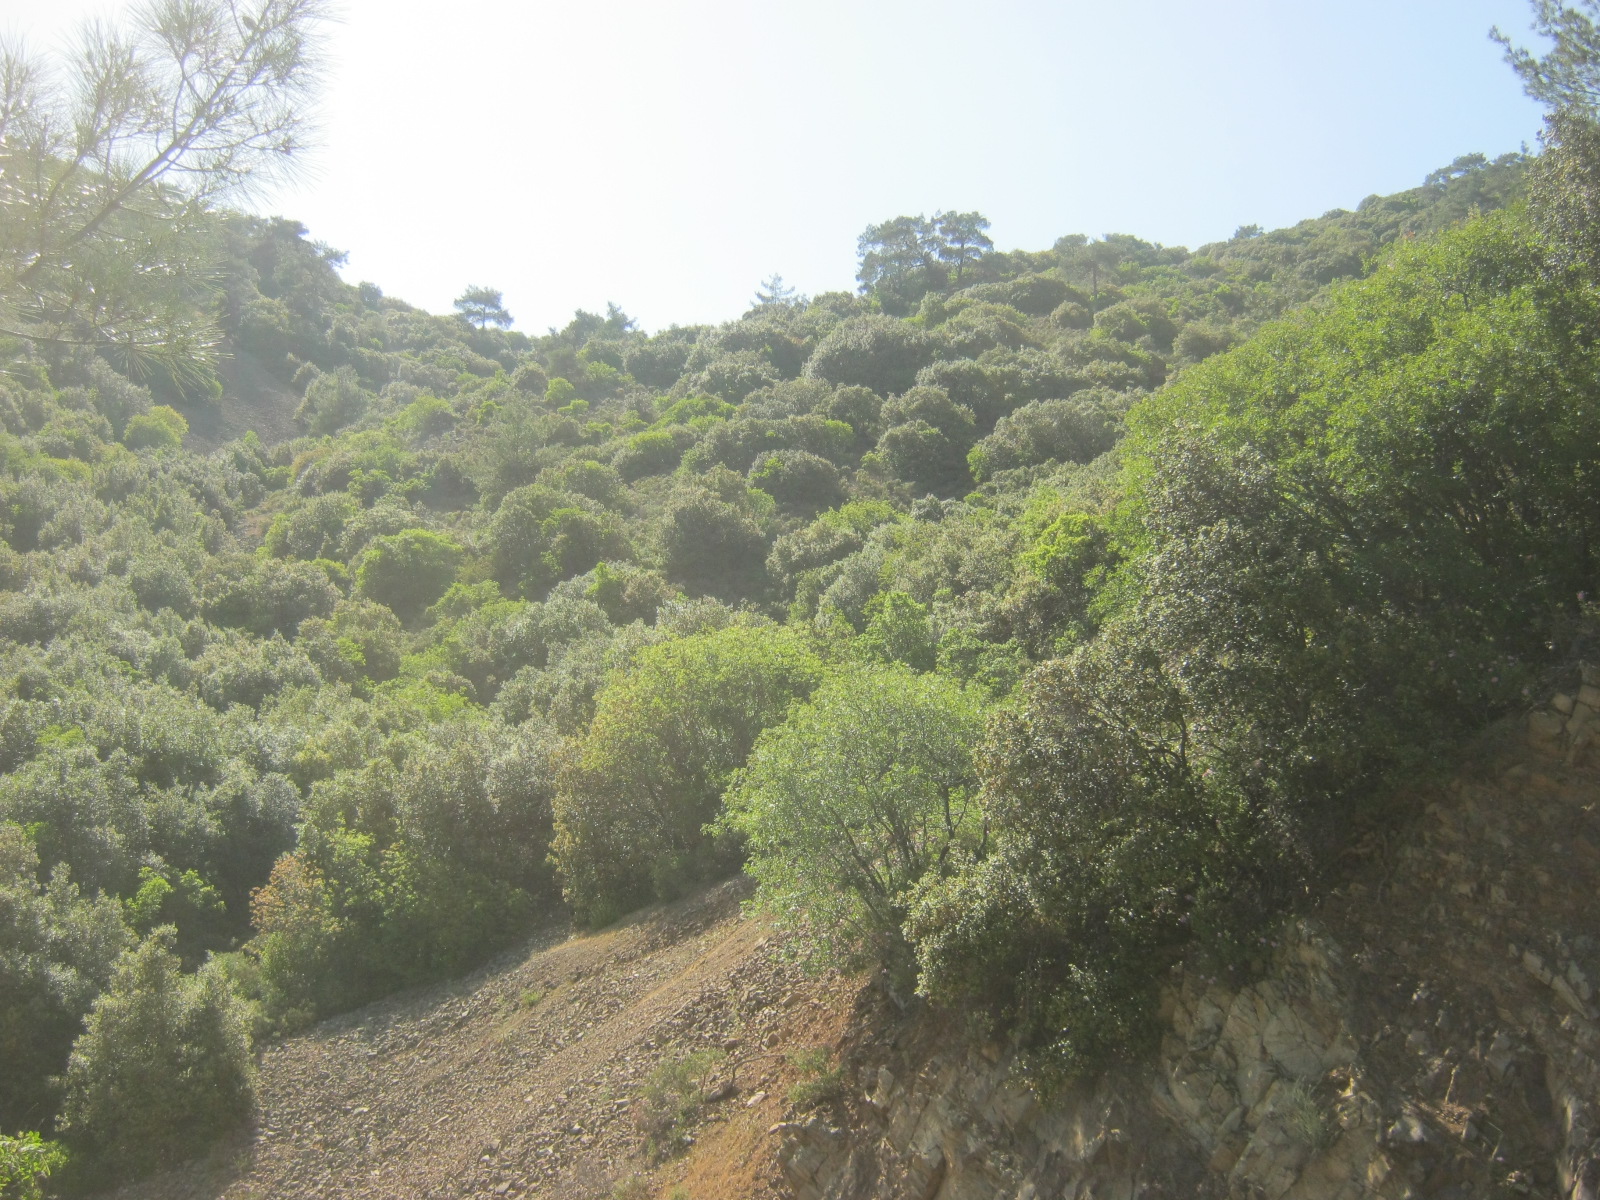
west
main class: Woodland
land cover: Pine dominated coniferous woodland
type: coniferous forest of the mediterranean region
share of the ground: 50 - 75 %
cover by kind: coniferous forest trees 50 %, unconsolidated bare surface 20 %, herbaceous plants 15 %, shrubs 10 %, broadleaved forest trees 5 %
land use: Semi-natural and natural areas not in use
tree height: > 5 m
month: May
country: CY
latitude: 34.9572
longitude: 32.8006
